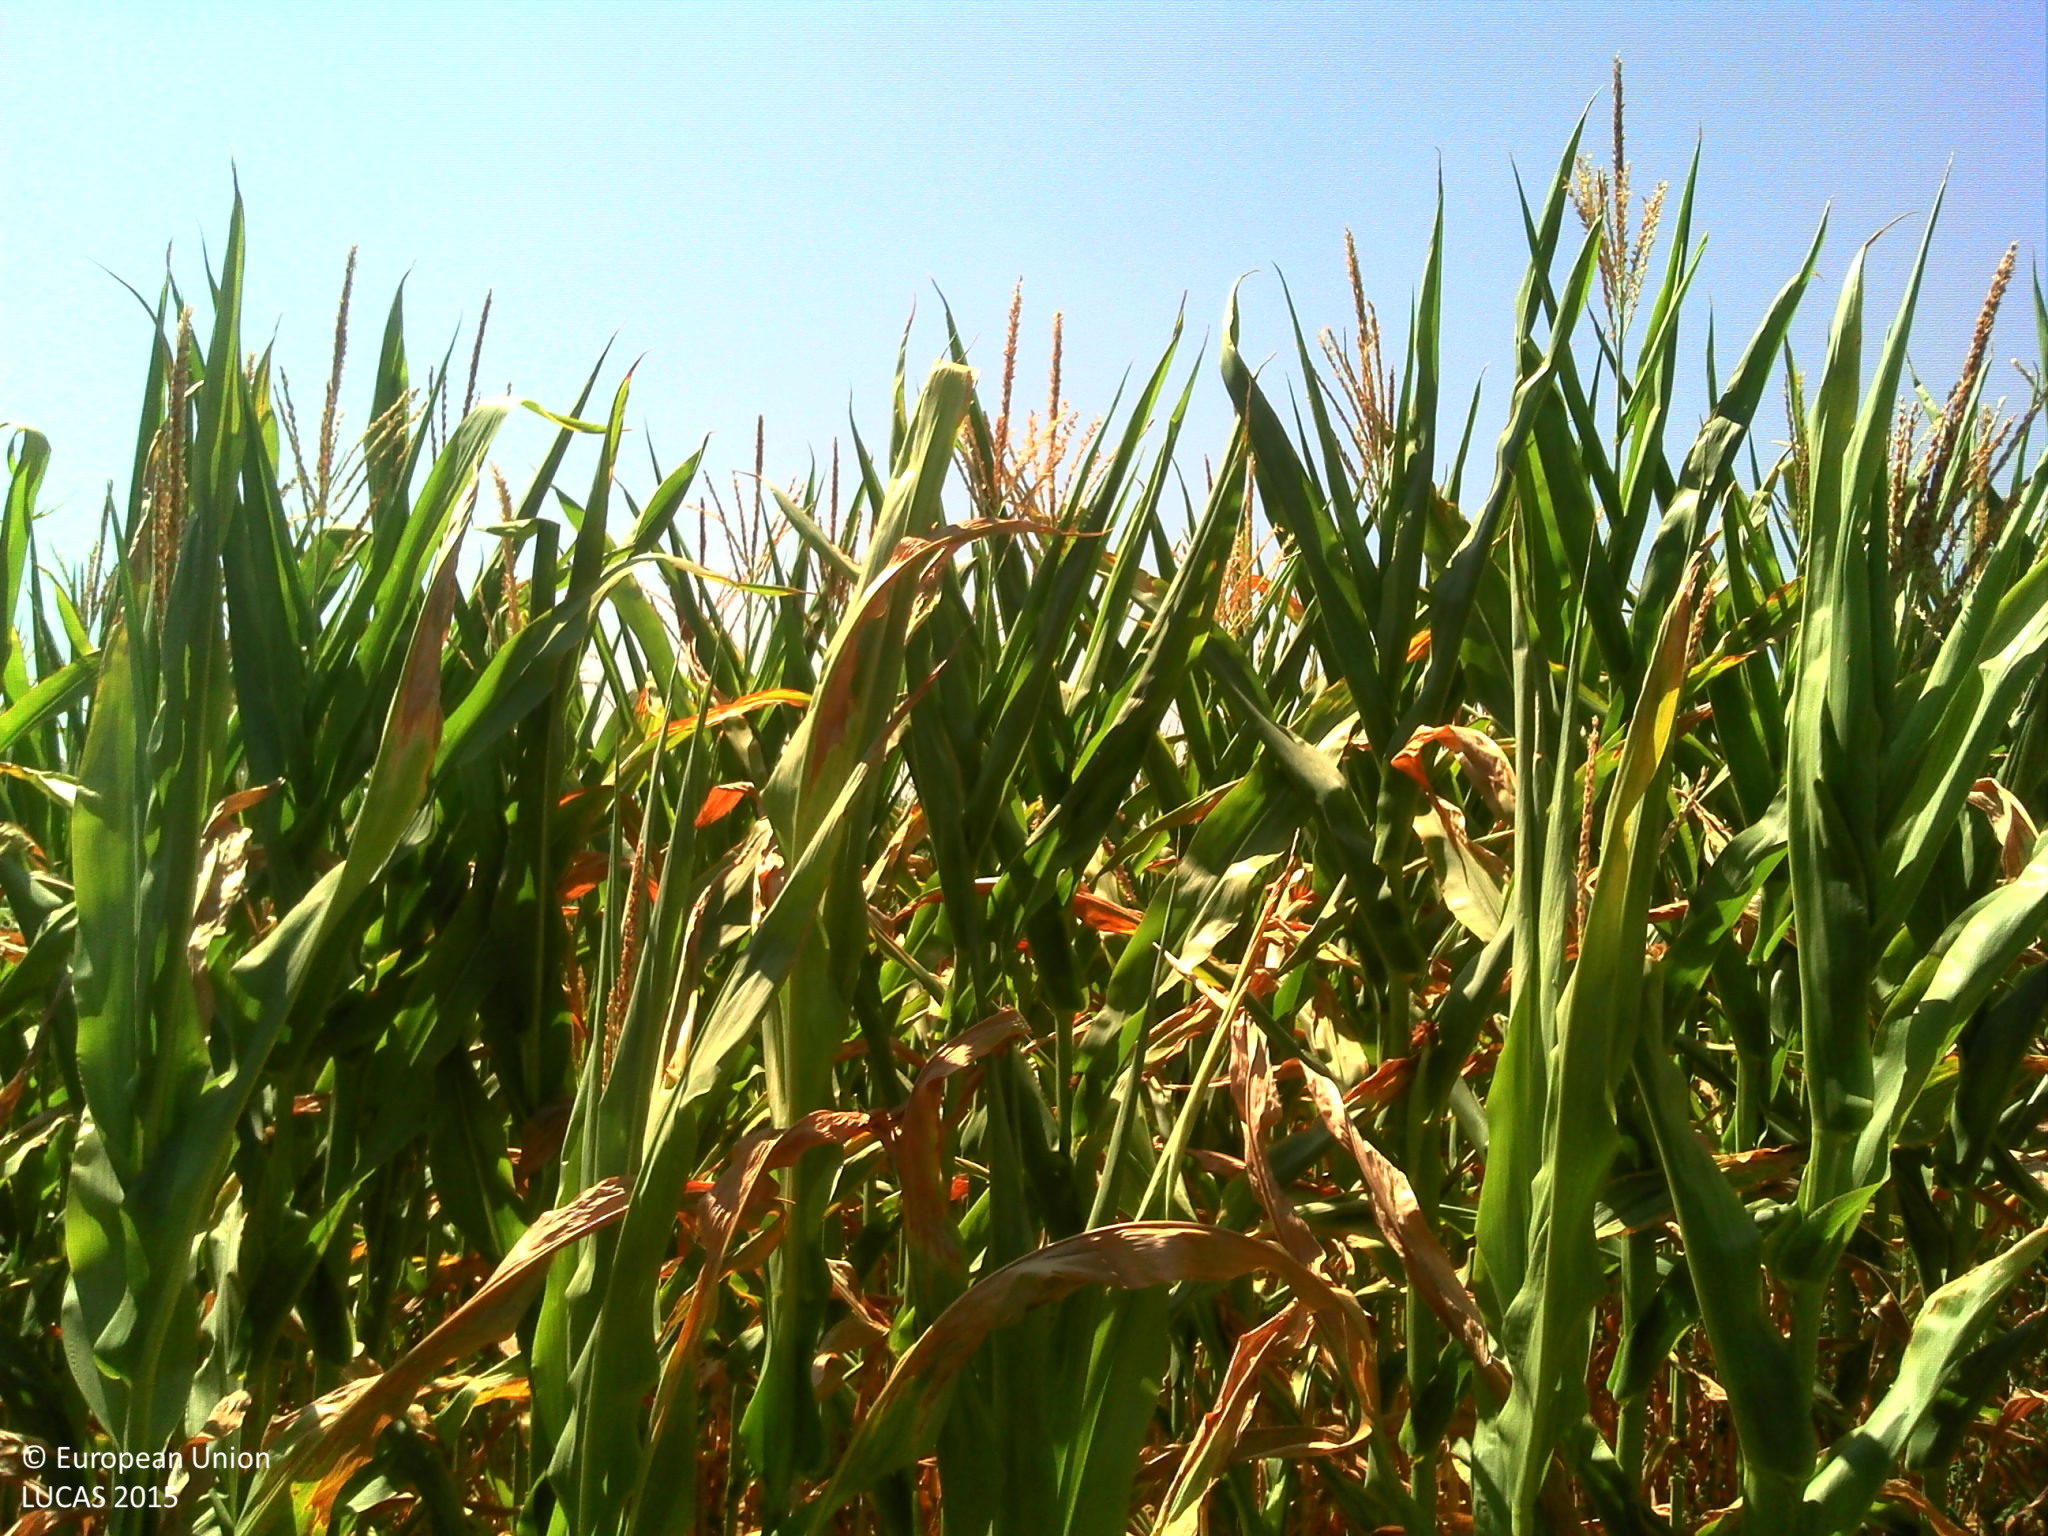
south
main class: Cropland
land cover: Maize
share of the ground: > 75 %
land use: Agriculture (excluding fallow land and kitchen gardens)
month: July
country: FR
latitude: 45.2006
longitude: 4.9001
